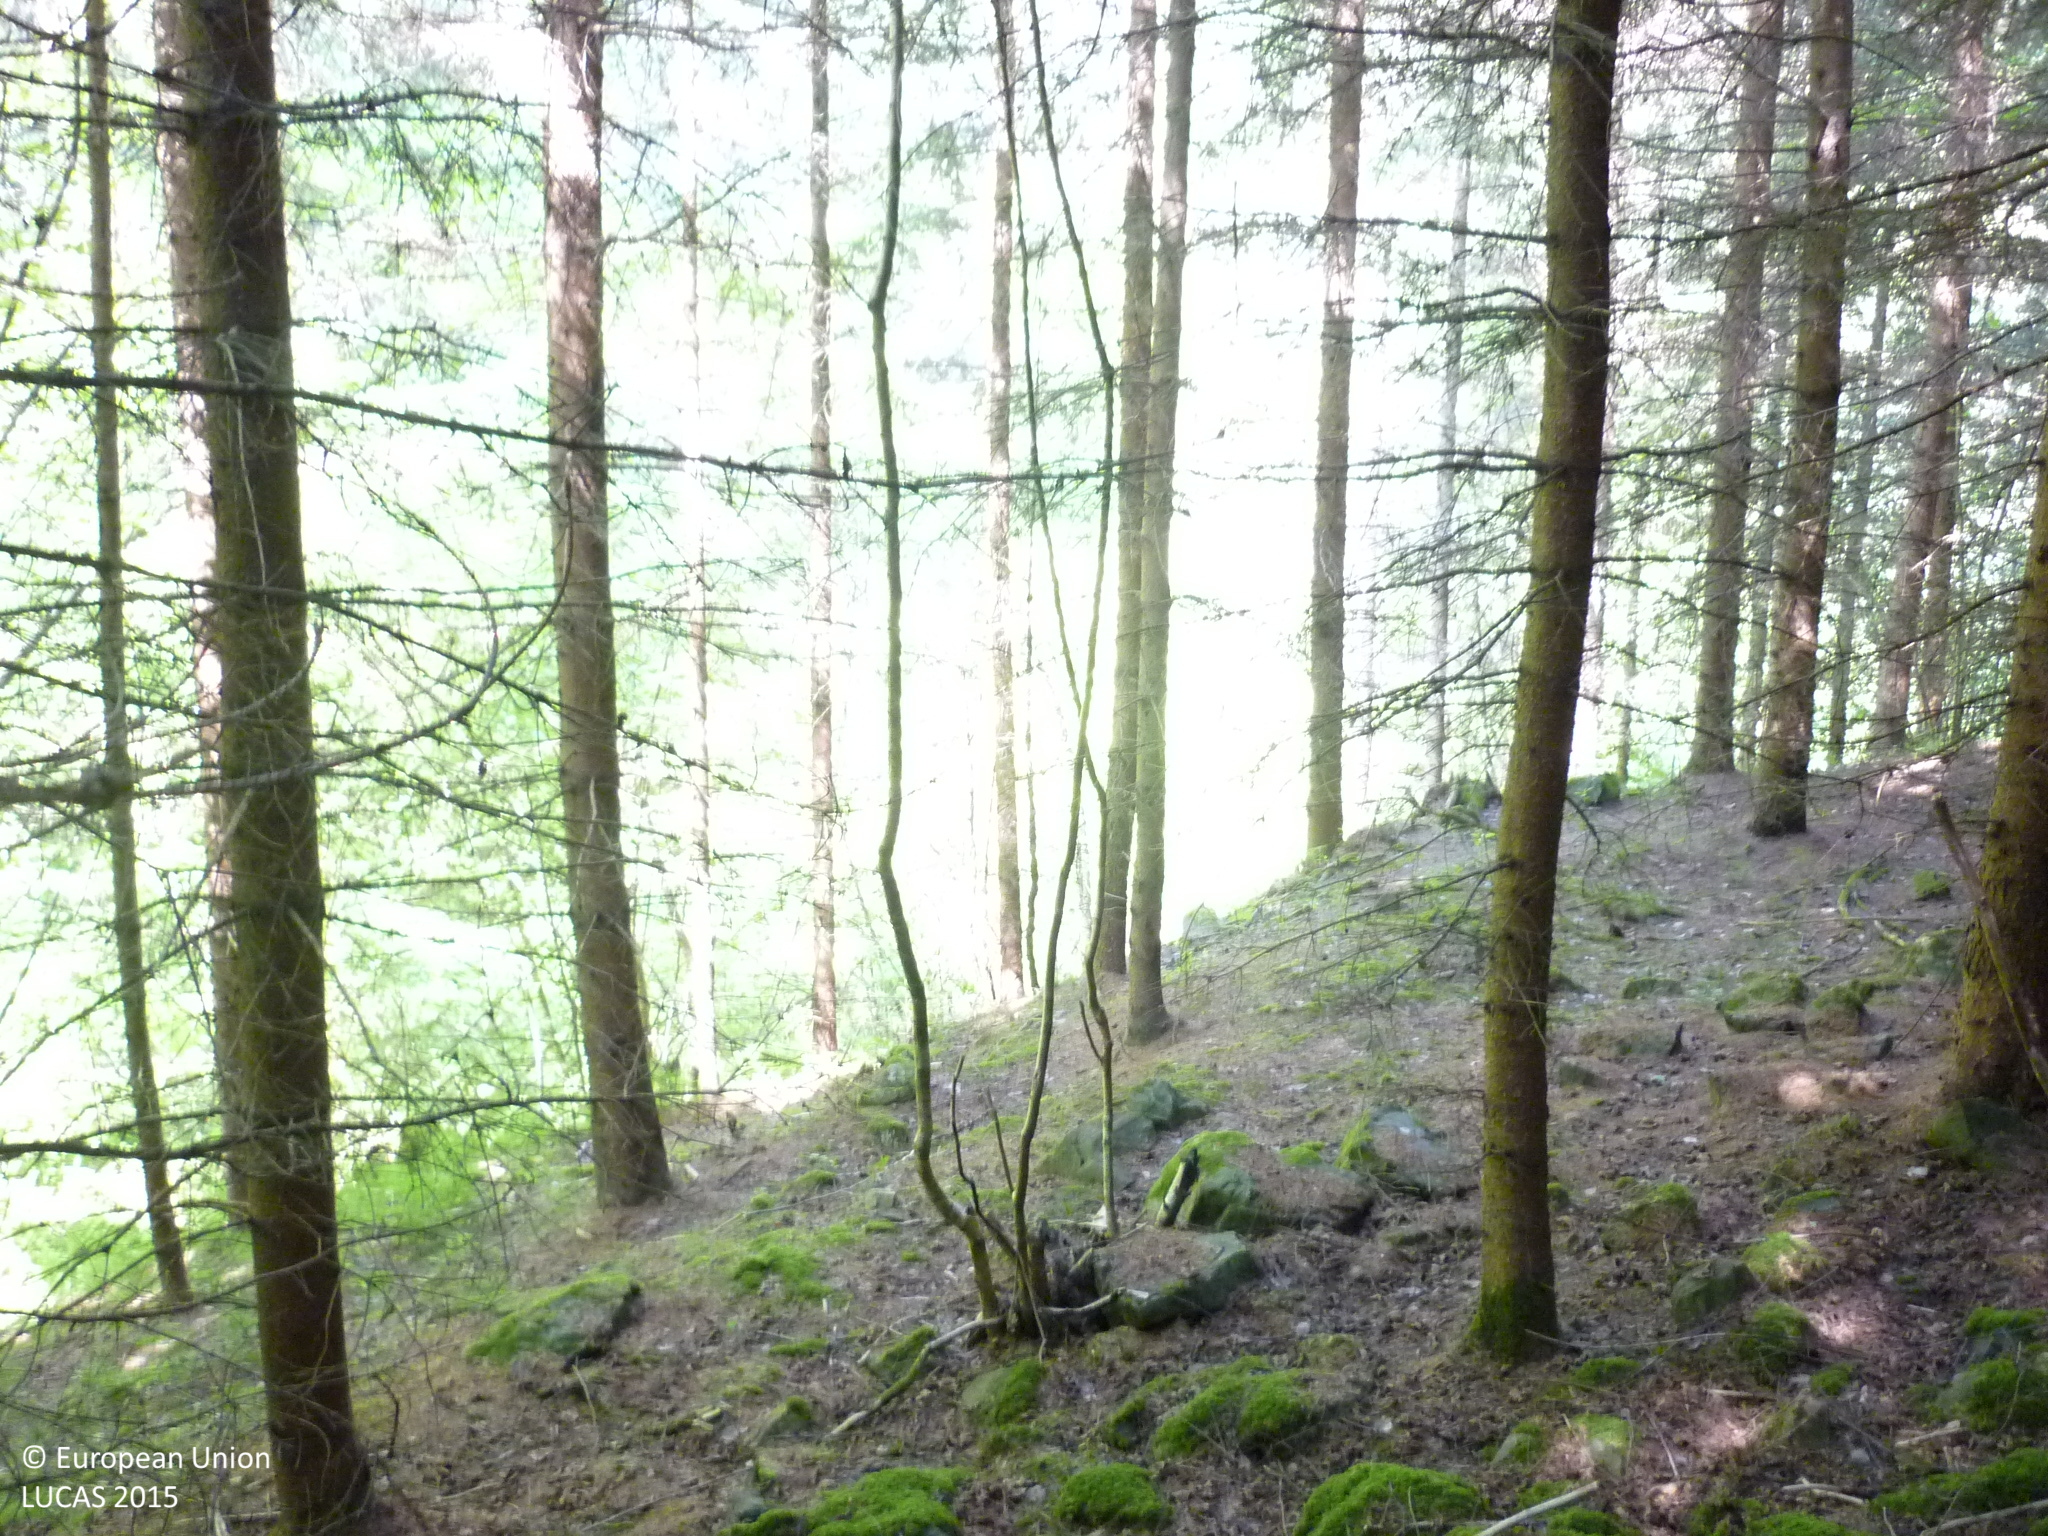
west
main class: Woodland
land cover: Spruce dominated coniferous woodland
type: alpine coniferous forest
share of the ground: > 75 %
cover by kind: coniferous forest trees 85 %, shrubs 15 %
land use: Forestry
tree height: > 5 m
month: May
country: AT
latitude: 47.3006
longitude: 14.9590
